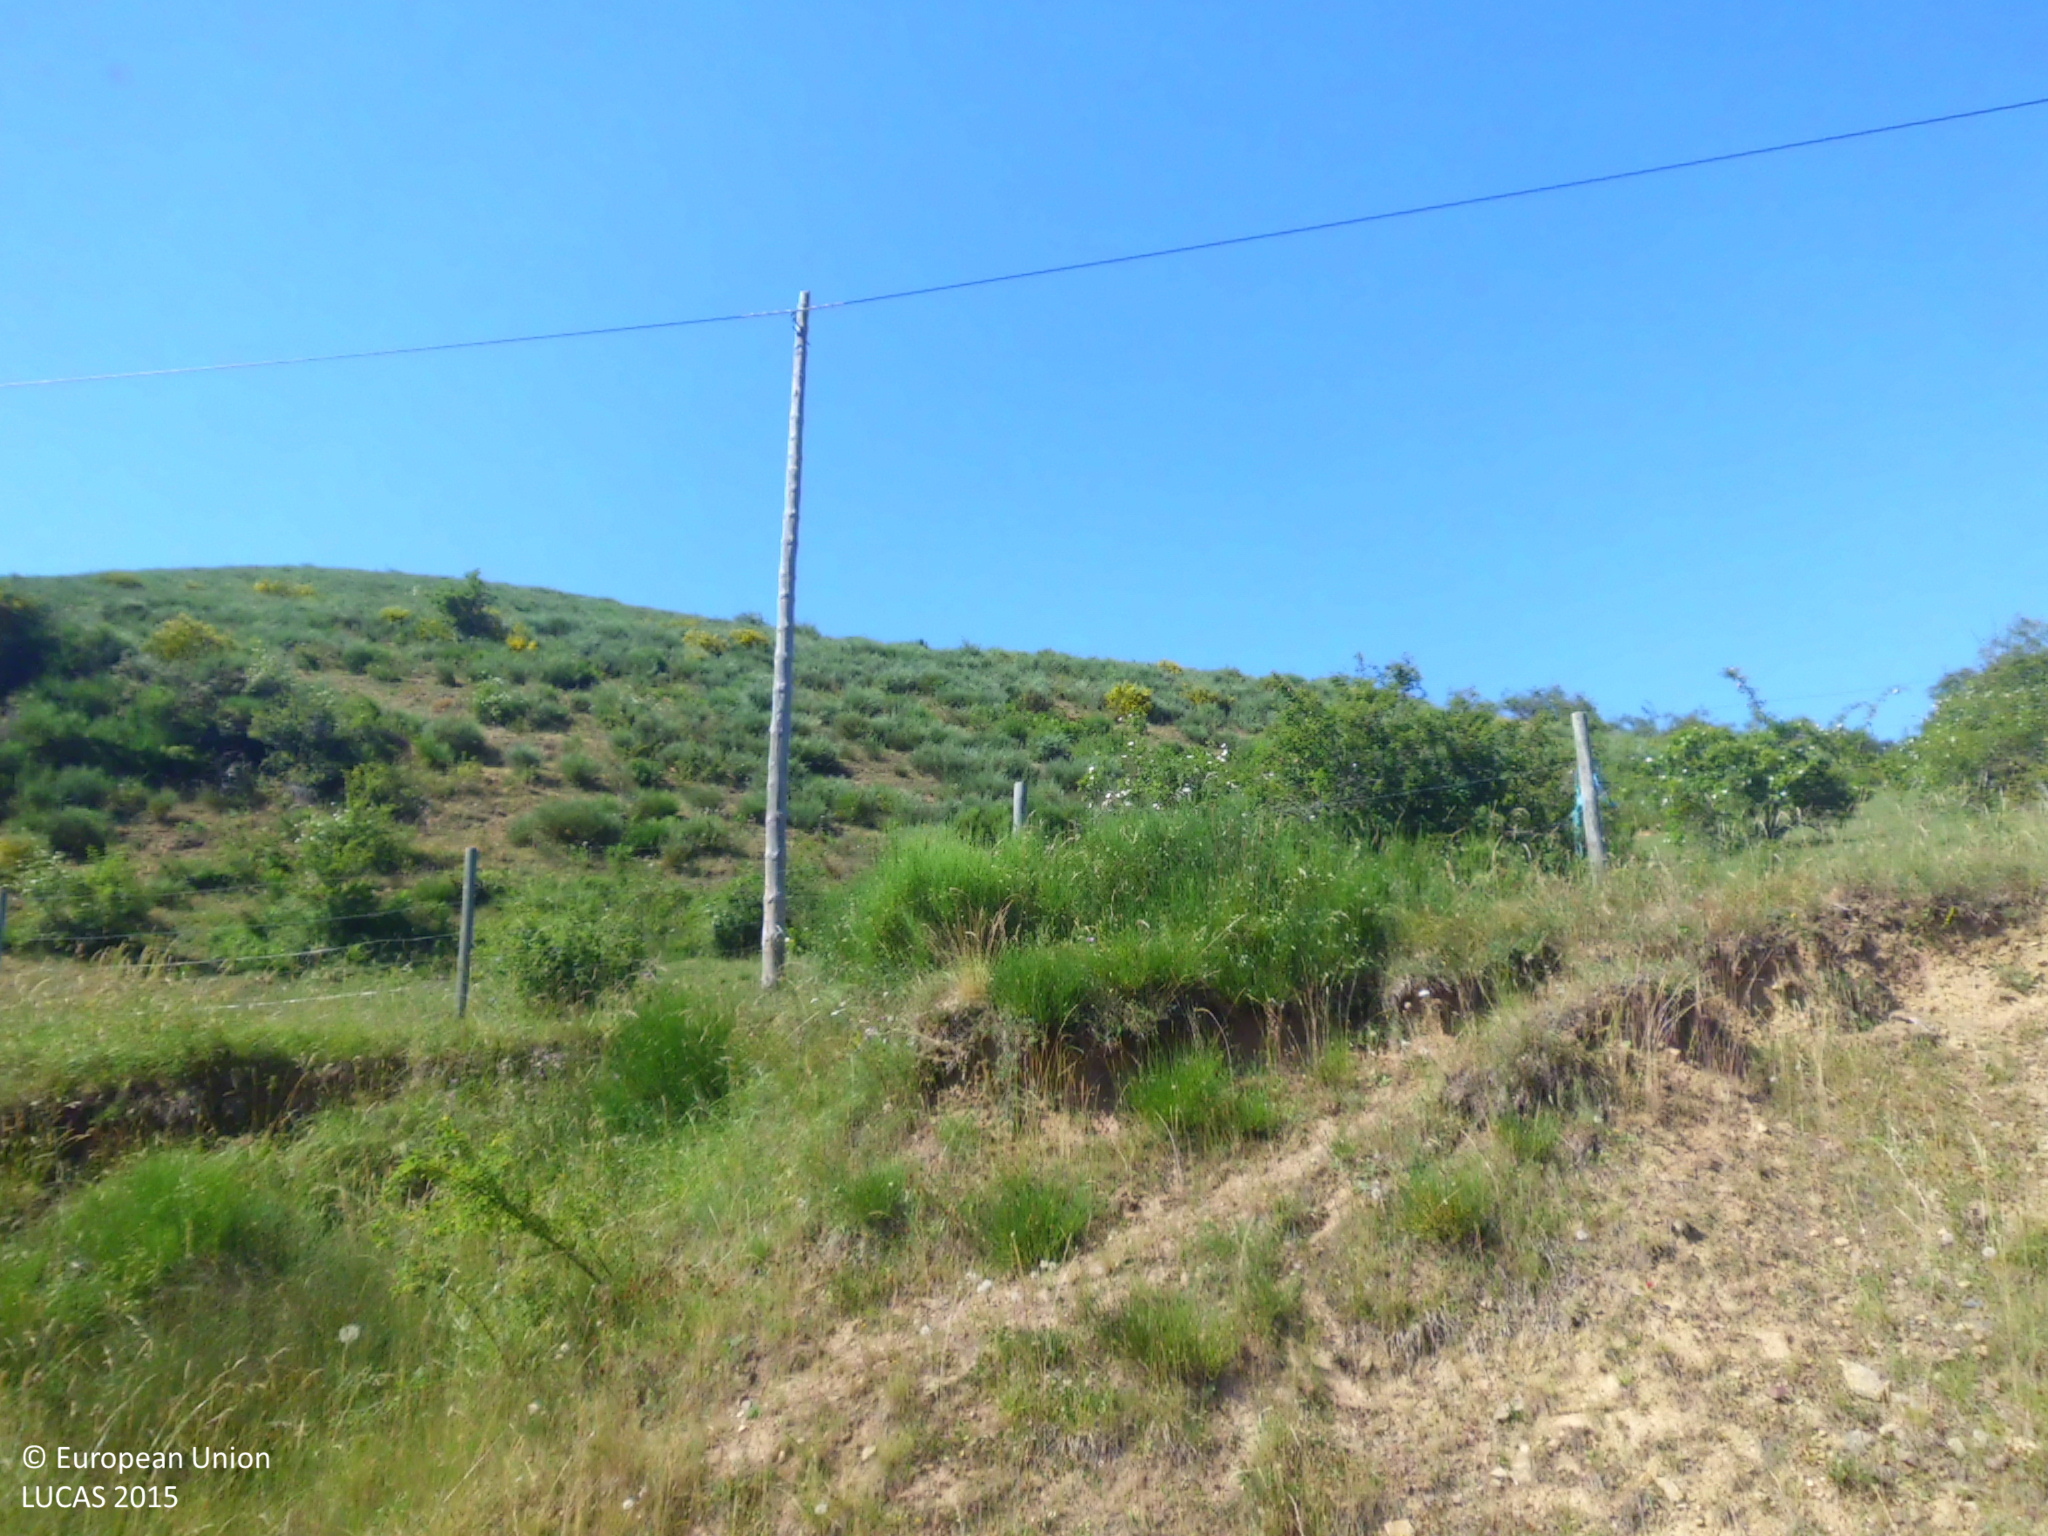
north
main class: Shrubland
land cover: Shrubland with sparse tree cover
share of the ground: > 75 %
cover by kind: shrubs 75 %, herbaceous plants 20 %, broadleaved forest trees 5 %
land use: Agriculture (excluding fallow land and kitchen gardens)
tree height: < 5 m
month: June
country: ES
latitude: 42.9973
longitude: -4.9936
